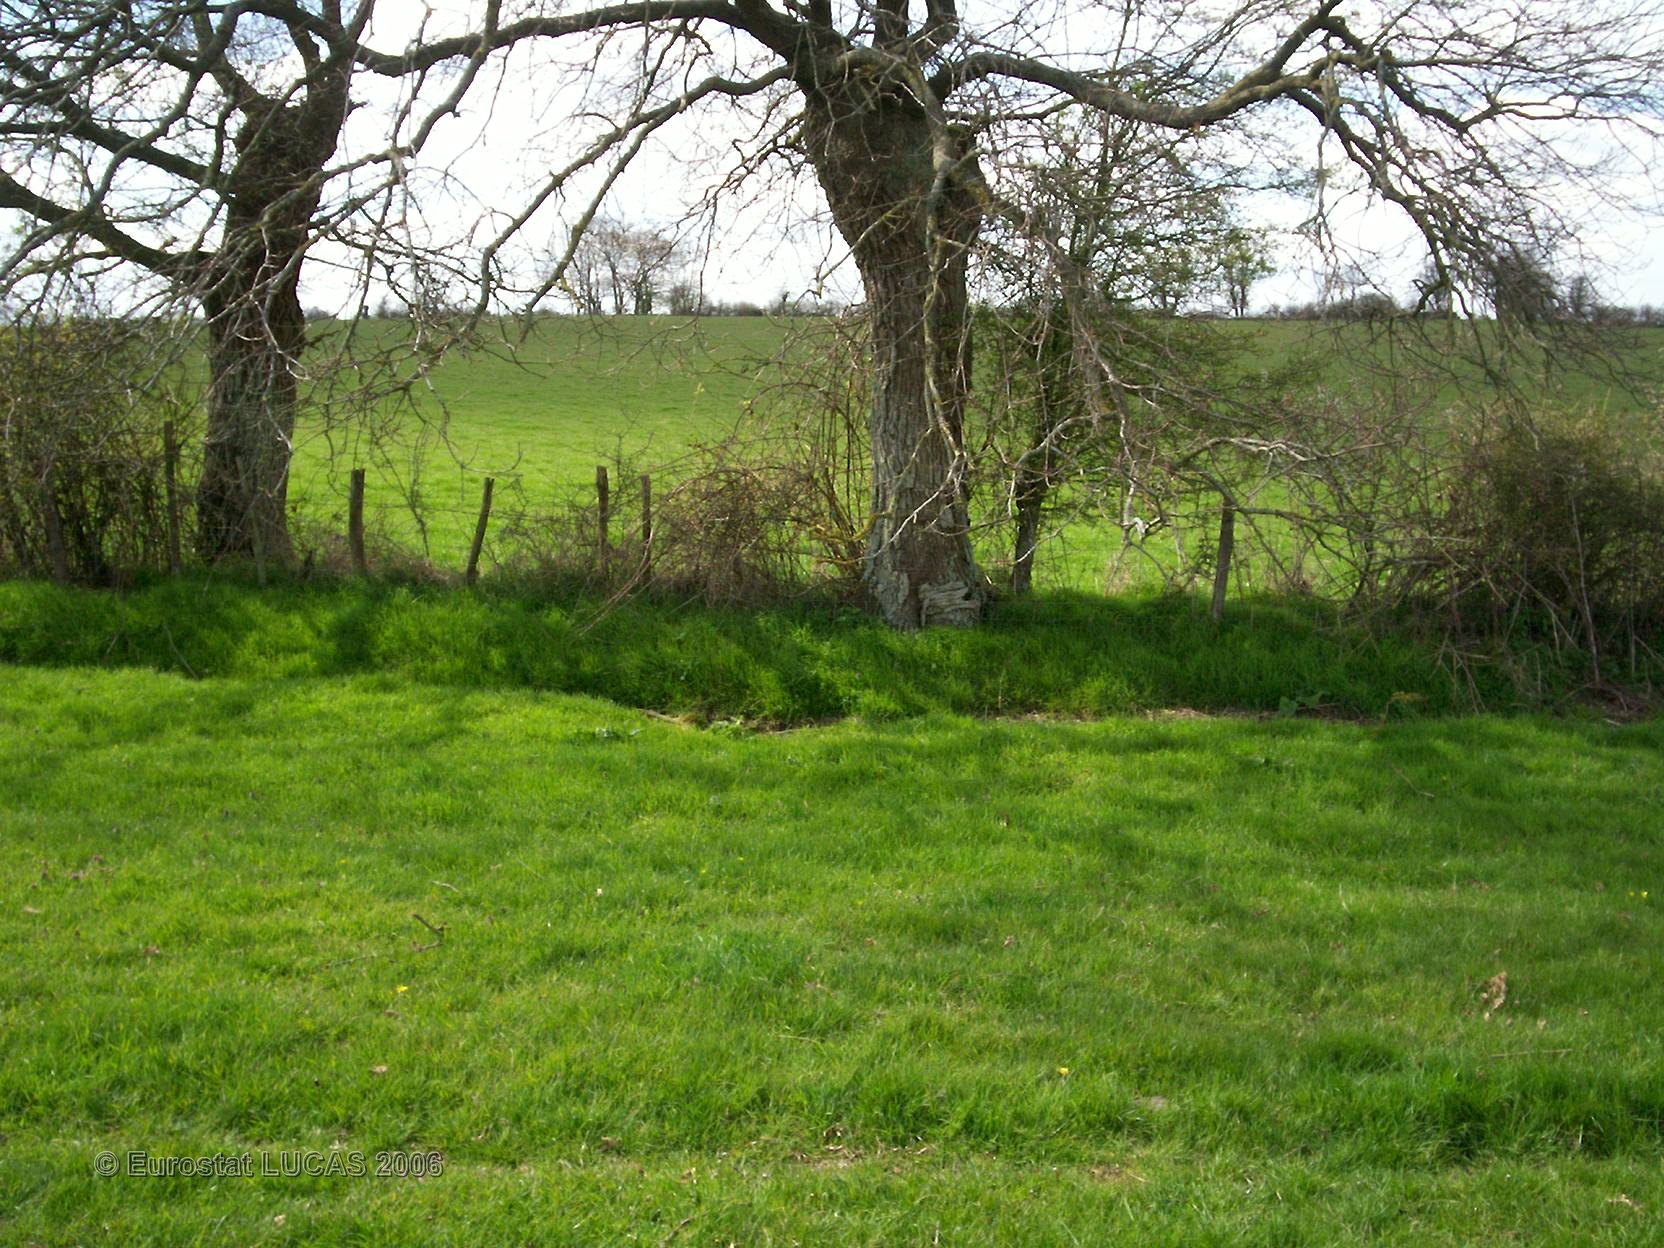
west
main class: Grassland
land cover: Grassland without tree/shrub cover
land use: Agriculture (excluding fallow land and kitchen gardens)
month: April
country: FR
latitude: 46.7726
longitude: -0.3589
